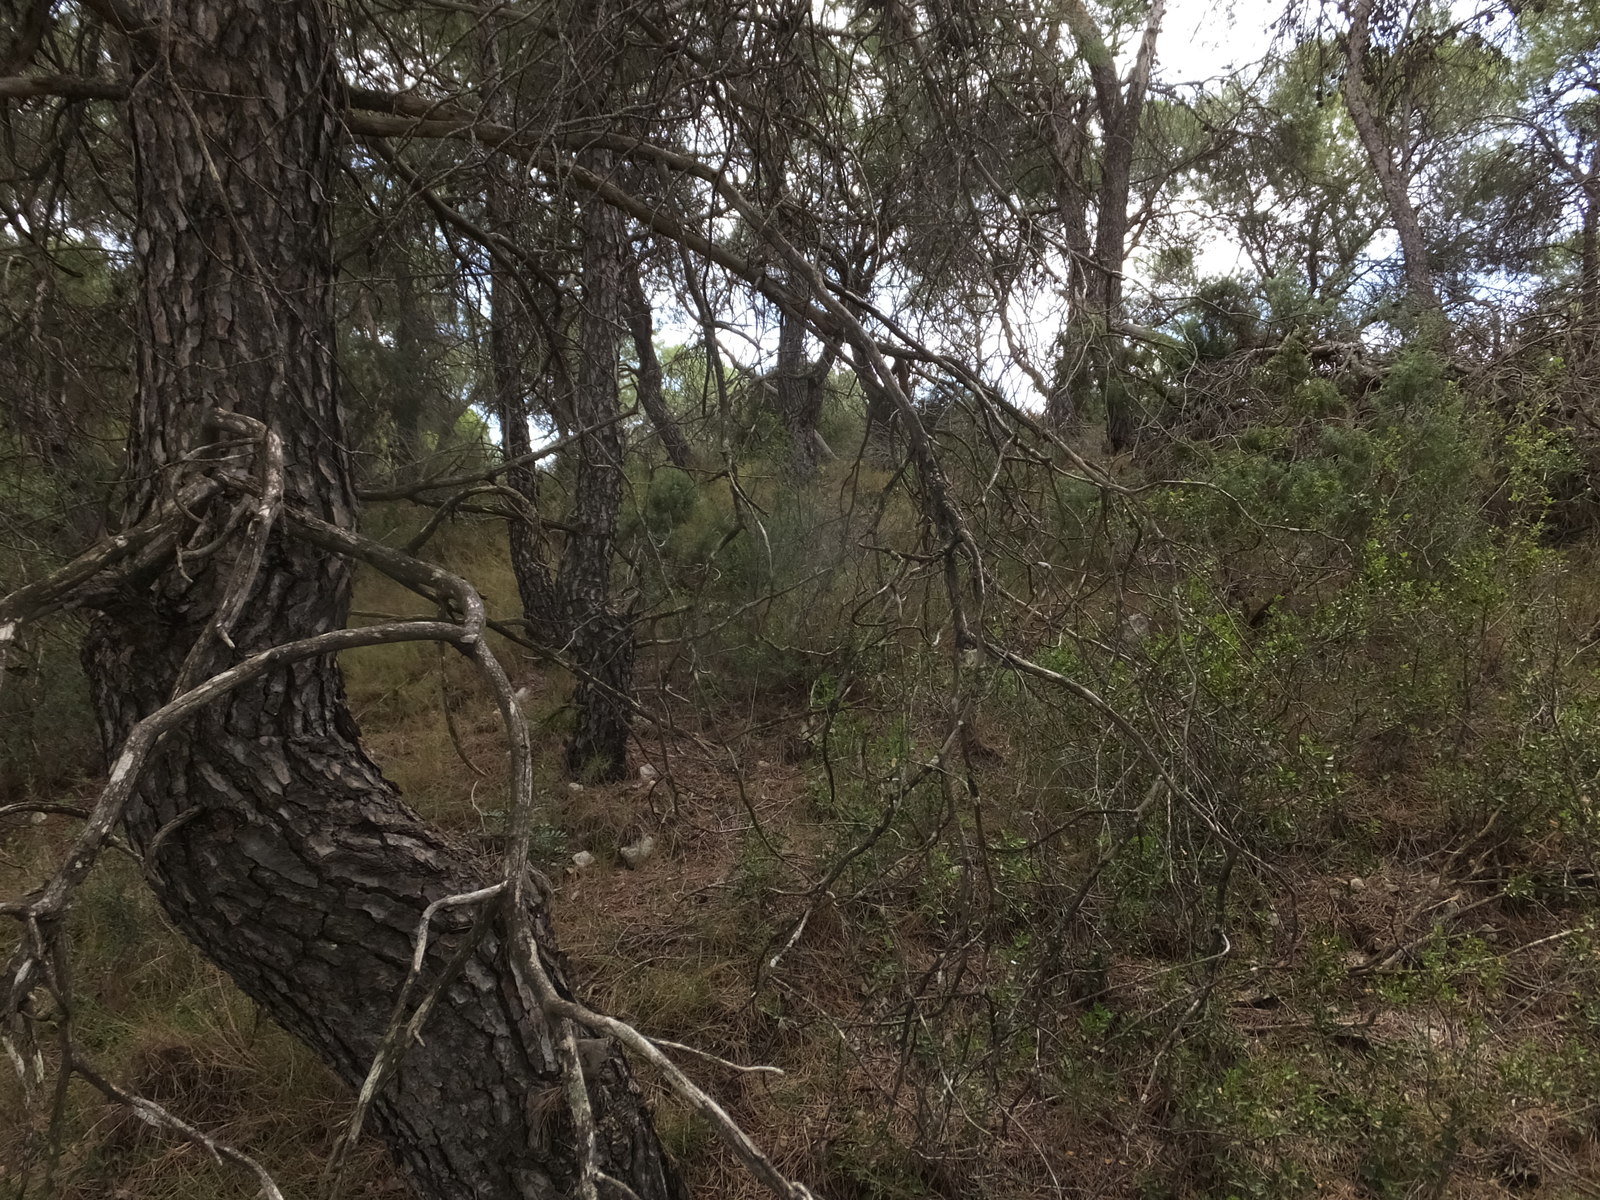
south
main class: Woodland
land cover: Pine dominated mixed woodland
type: coniferous forest of the mediterranean region
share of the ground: 50 - 75 %
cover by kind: coniferous forest trees 60 %, broadleaved forest trees 20 %, shrubs 15 %, herbaceous plants 5 %
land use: Forestry
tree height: > 5 m
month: August
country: ES
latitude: 41.3412
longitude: 0.2005
